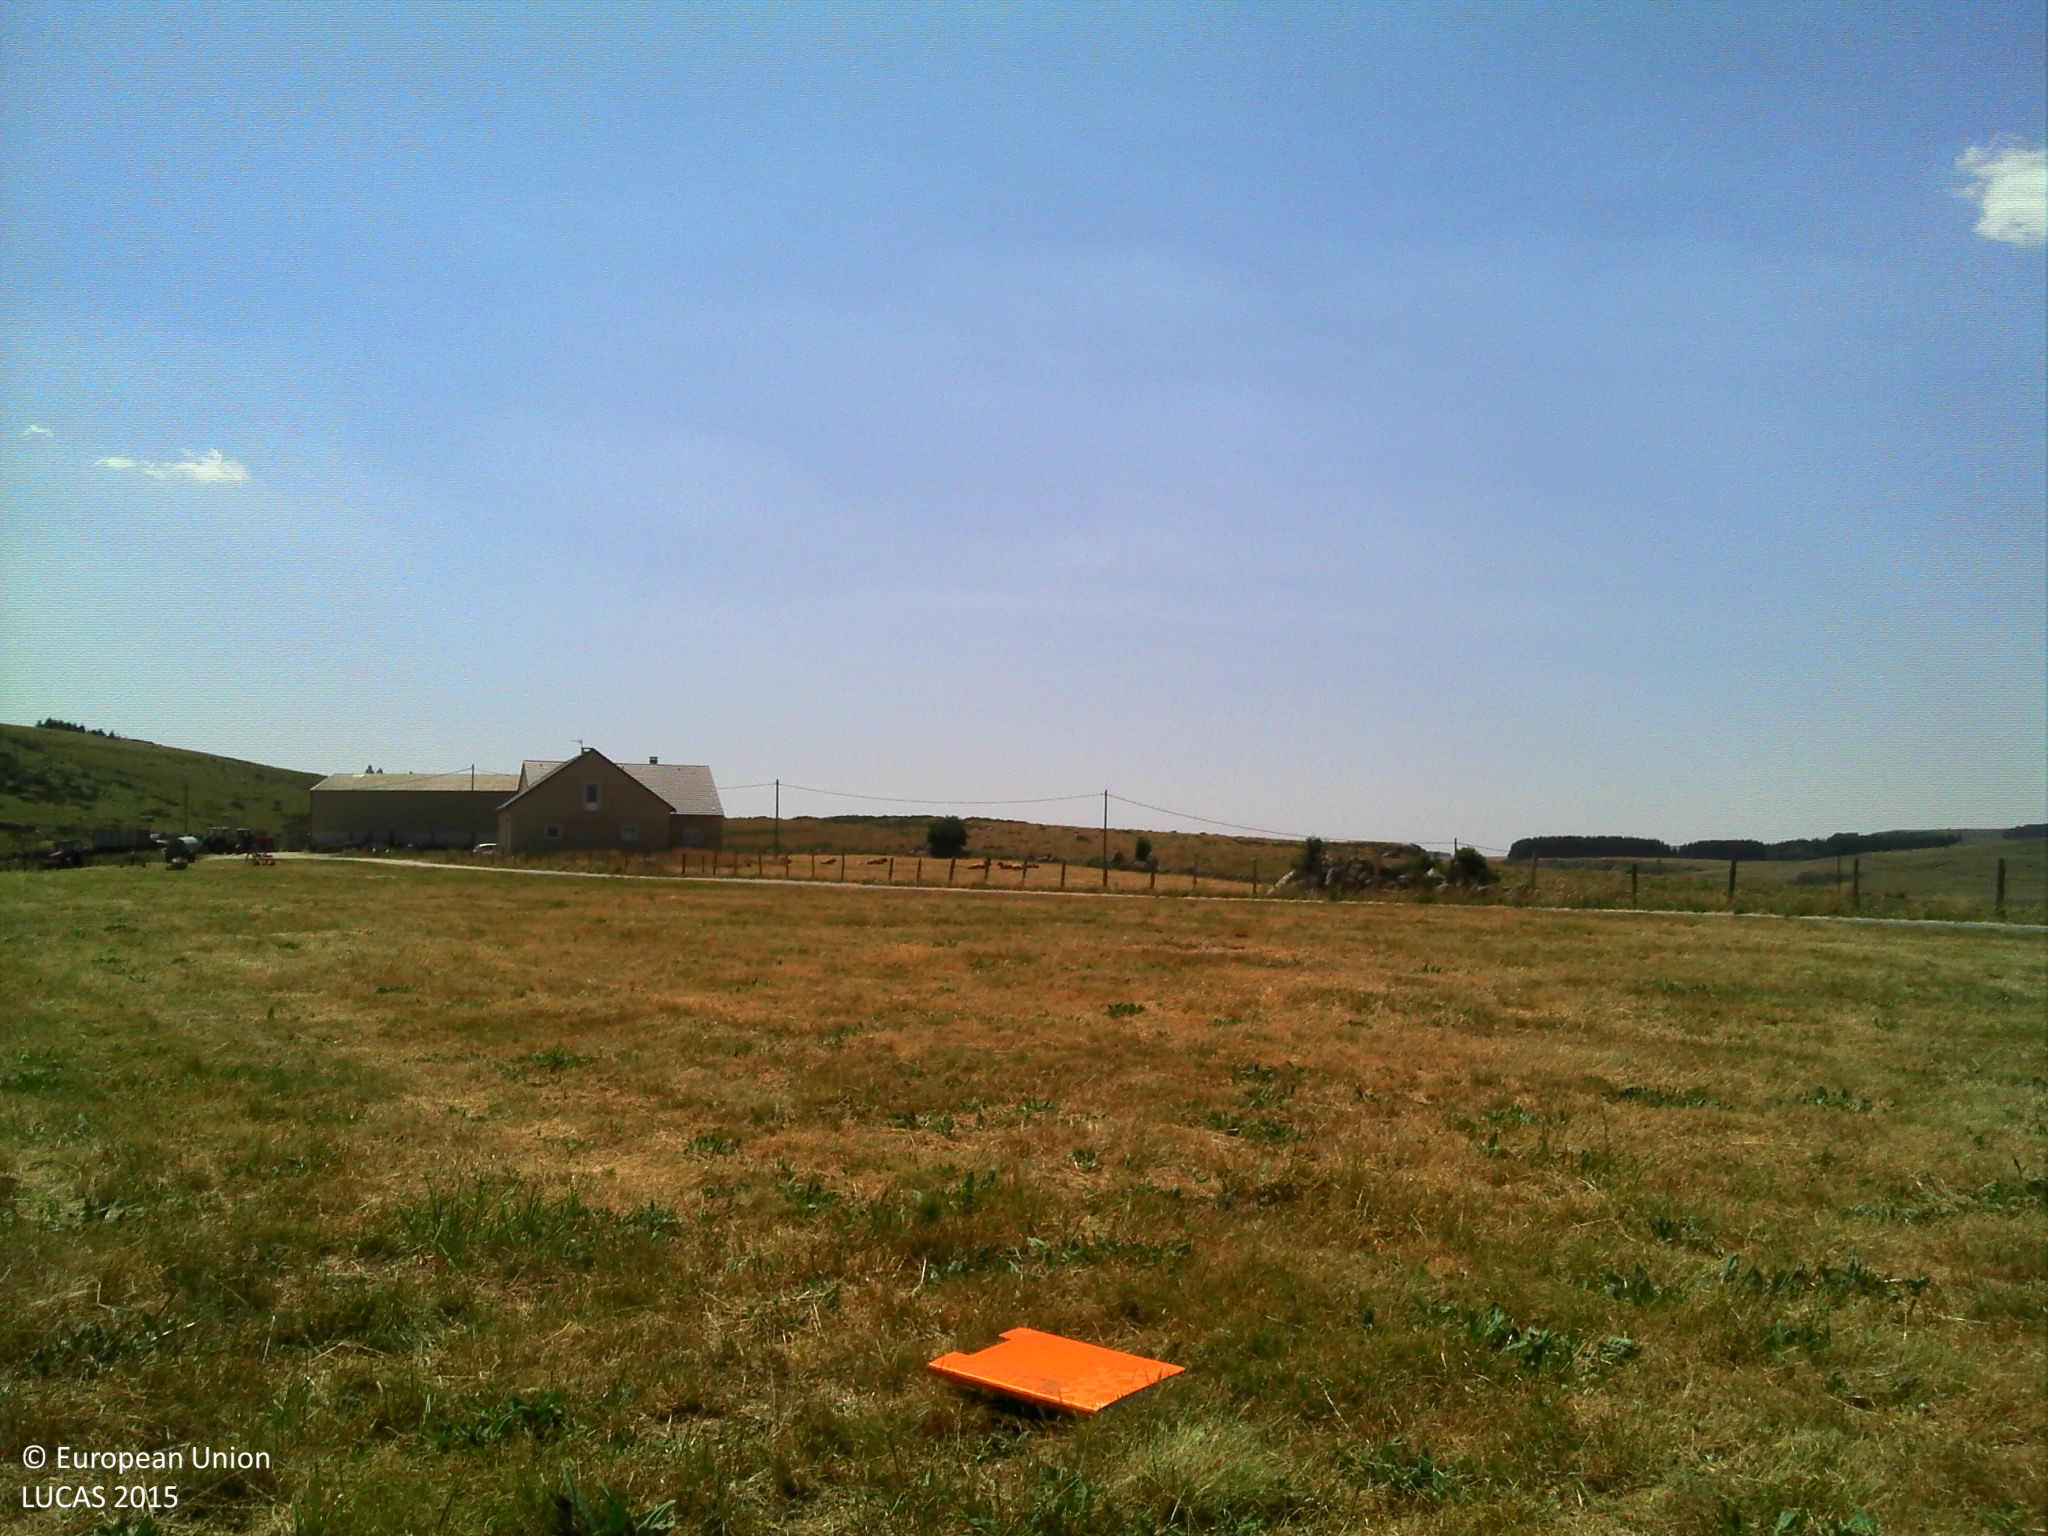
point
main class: Grassland
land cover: Grassland without tree/shrub cover
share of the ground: > 75 %
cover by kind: herbaceous plants 100 %
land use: Agriculture (excluding fallow land and kitchen gardens)
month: July
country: FR
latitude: 44.6443
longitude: 3.0819
